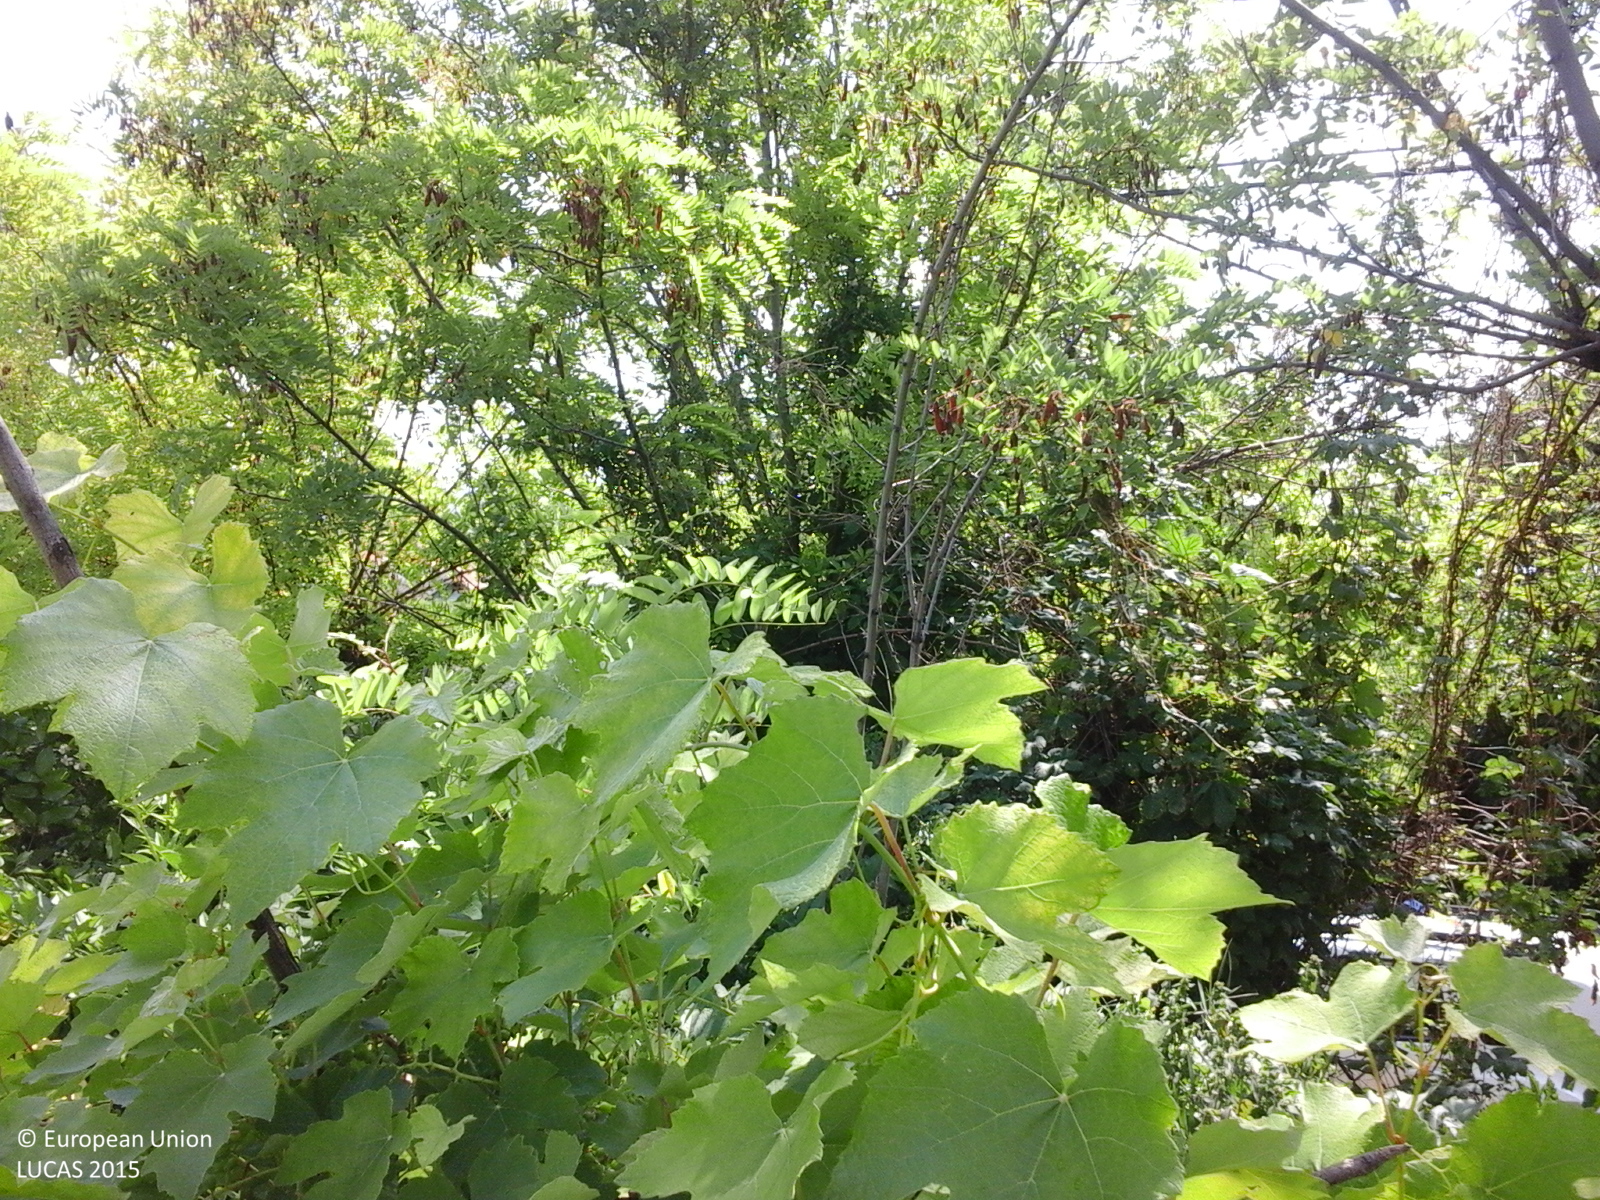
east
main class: Cropland
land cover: Vineyards
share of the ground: 50 - 75 %
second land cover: Grassland without tree/shrub cover
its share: 10 - 25 %
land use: Agriculture (excluding fallow land and kitchen gardens)
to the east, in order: Vineyards; Grassland without tree/shrub cover; Abandoned hedges; Grass margins; Artificial constructions in urban areas; Vineyards; Abandoned hedges; Grass margins; Paved roads, cycling and walking lanes; Grass margins; Electric lines; Grass margins; Fences; Tomatoes; Arable land (only in case pi); Abandoned hedges; Arable land (only in case pi); Abandoned hedges; Permanent crops (only in case pi); Abandoned hedges; Arable land (only in case pi)
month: June
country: RO
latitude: 47.4781
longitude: 26.8858
